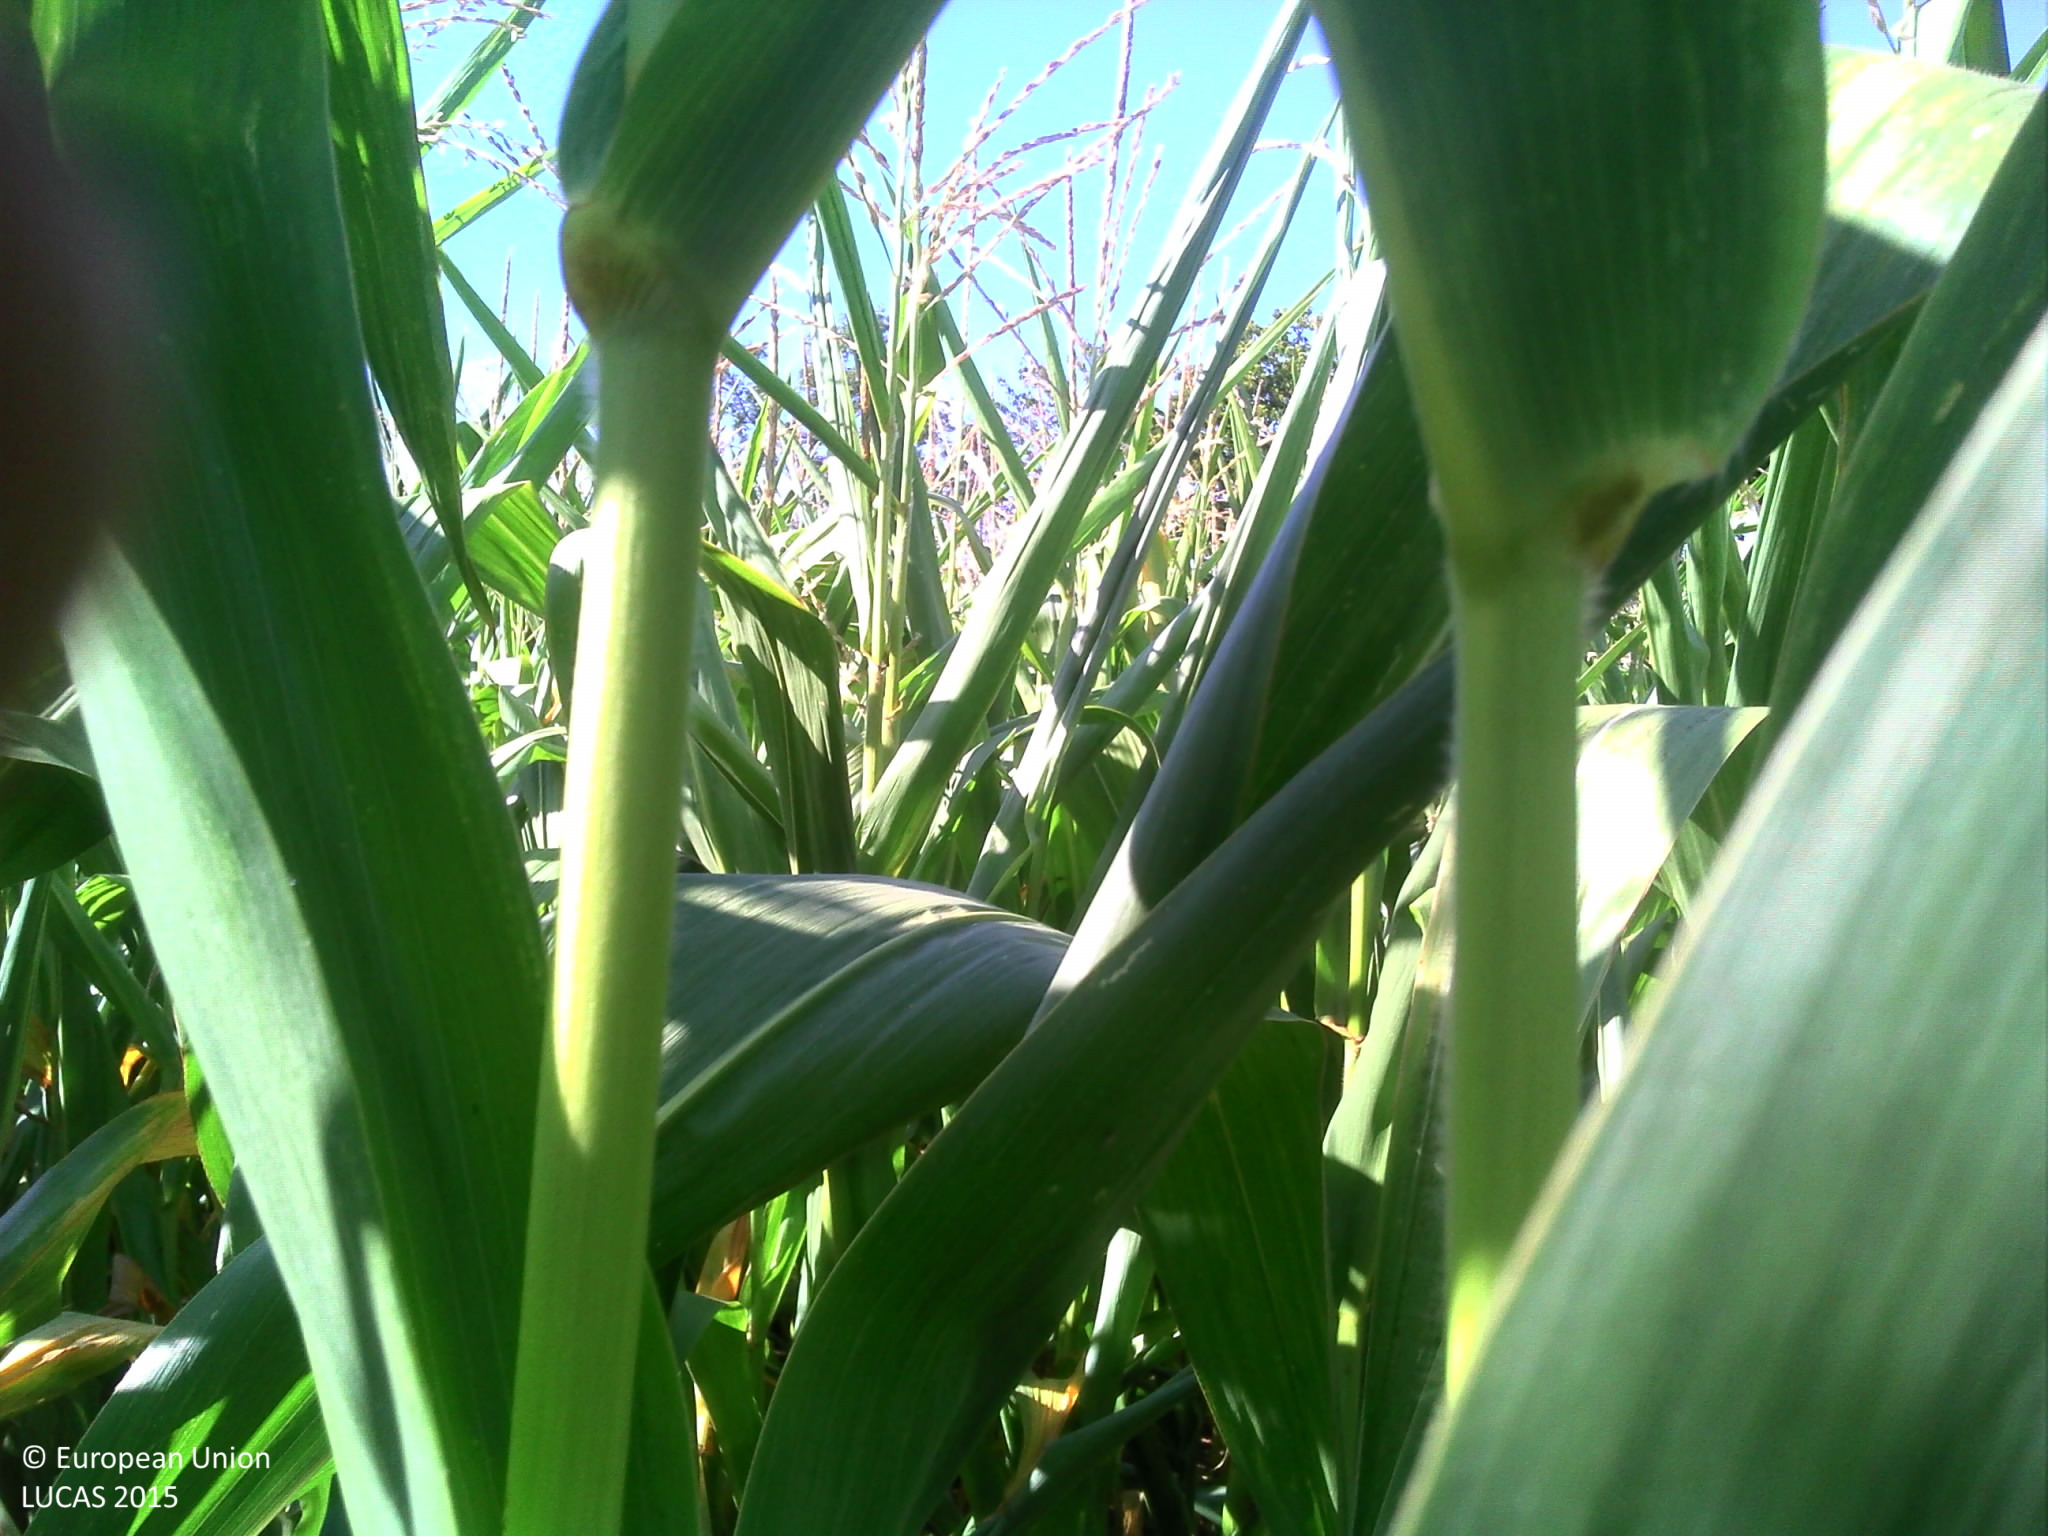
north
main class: Cropland
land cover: Maize
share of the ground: > 75 %
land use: Agriculture (excluding fallow land and kitchen gardens)
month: August
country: FR
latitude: 46.7438
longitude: -1.3591
